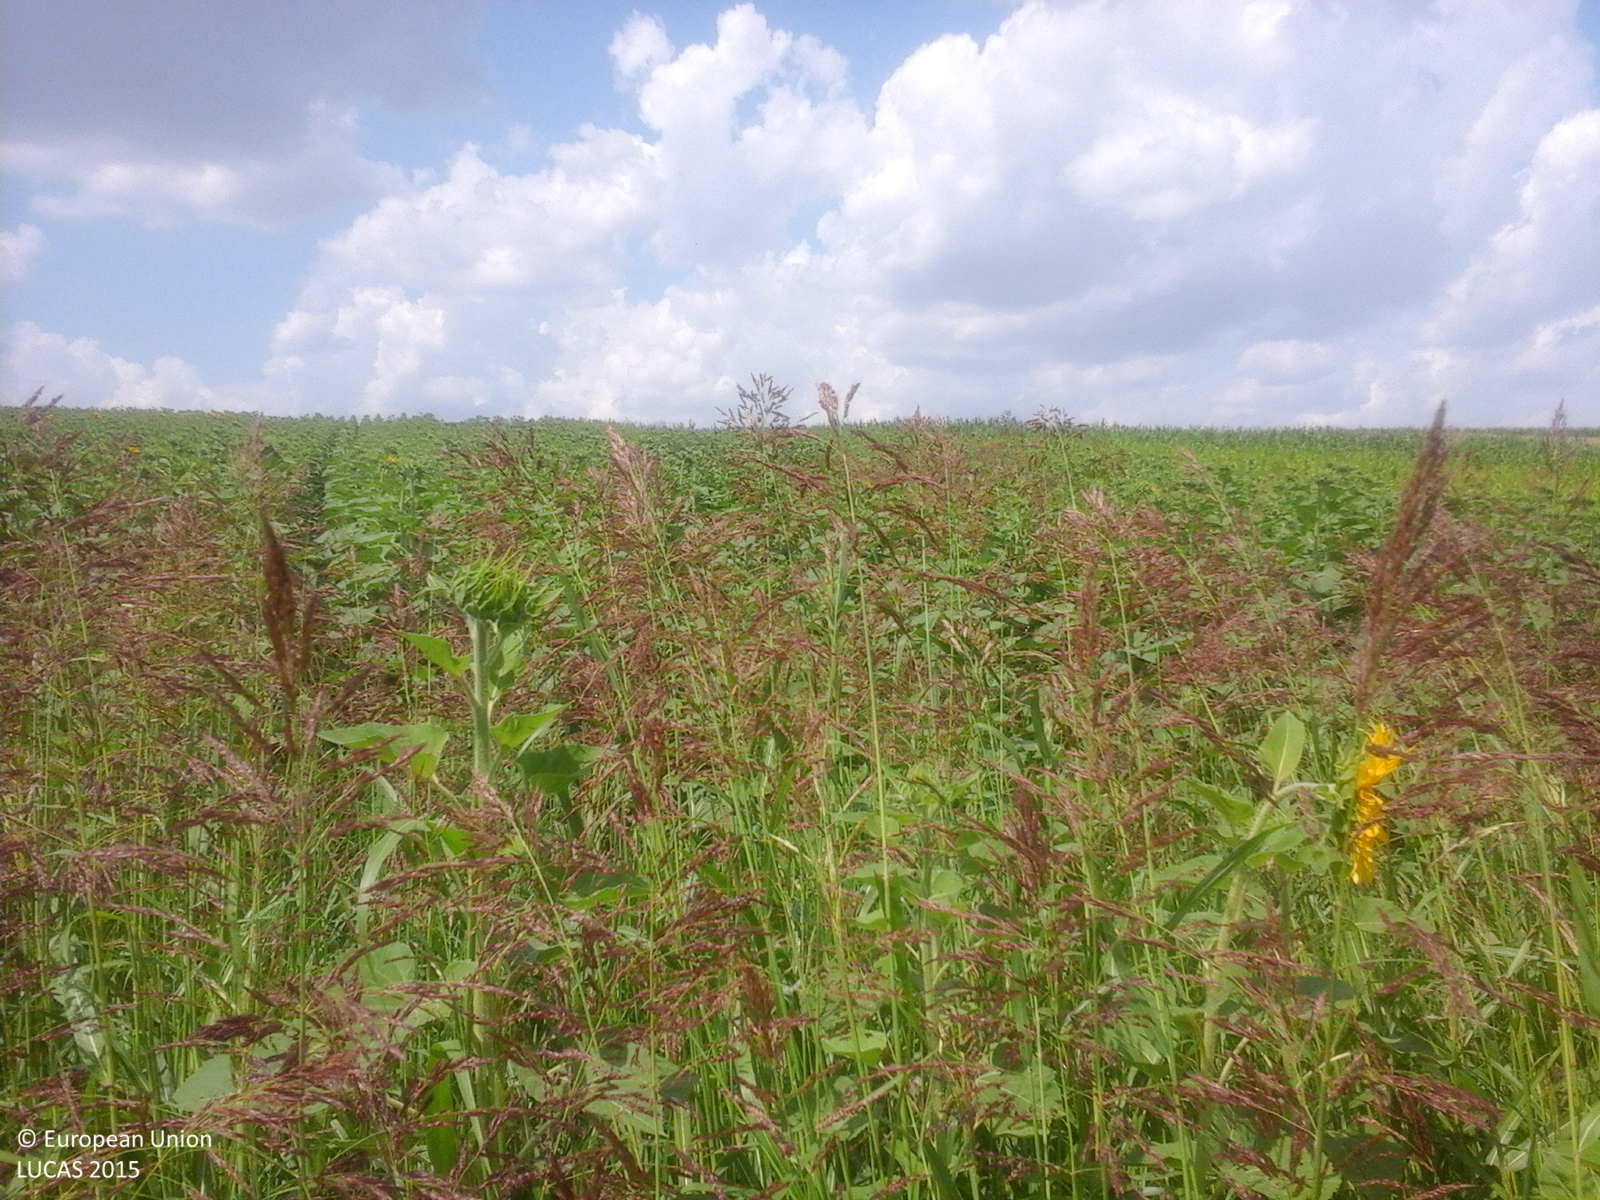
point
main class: Cropland
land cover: Sunflower
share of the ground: > 75 %
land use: Agriculture (excluding fallow land and kitchen gardens)
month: July
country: RO
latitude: 43.8576
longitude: 25.7289
